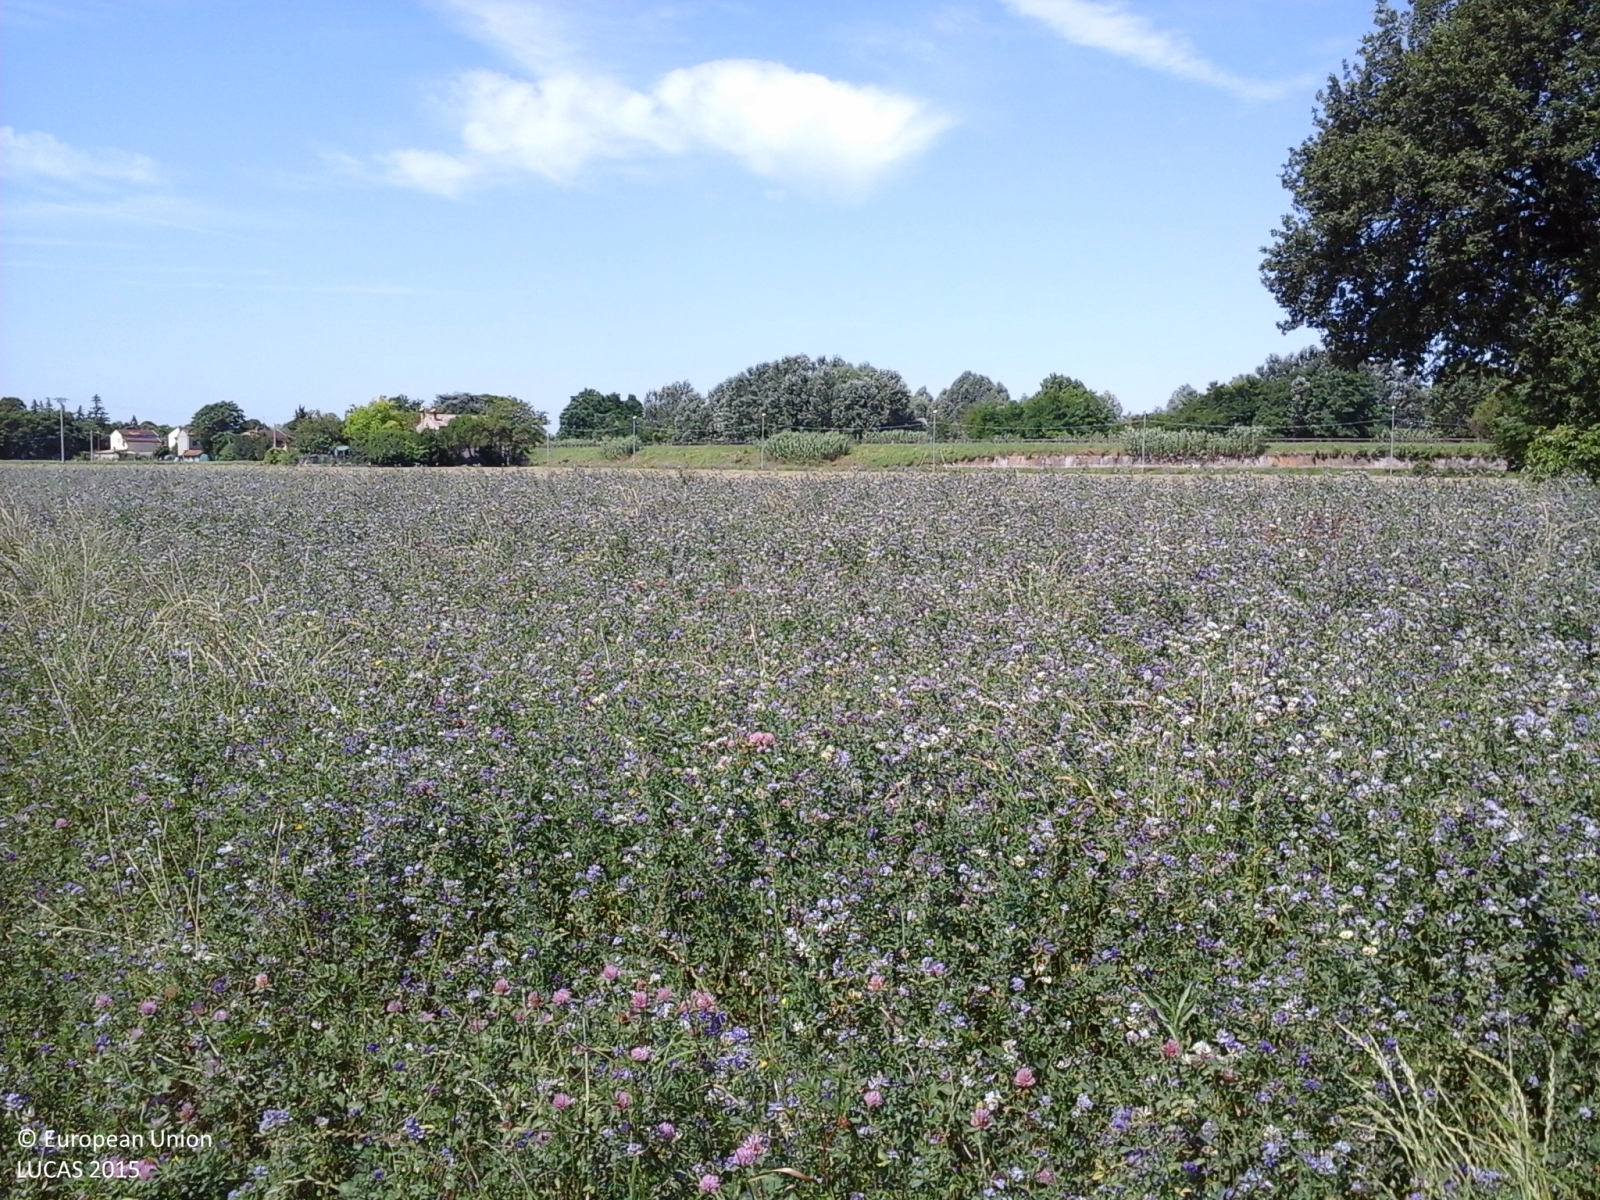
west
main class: Cropland
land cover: Lucerne
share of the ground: > 75 %
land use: Agriculture (excluding fallow land and kitchen gardens)
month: June
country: IT
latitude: 44.2537
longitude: 12.2619
